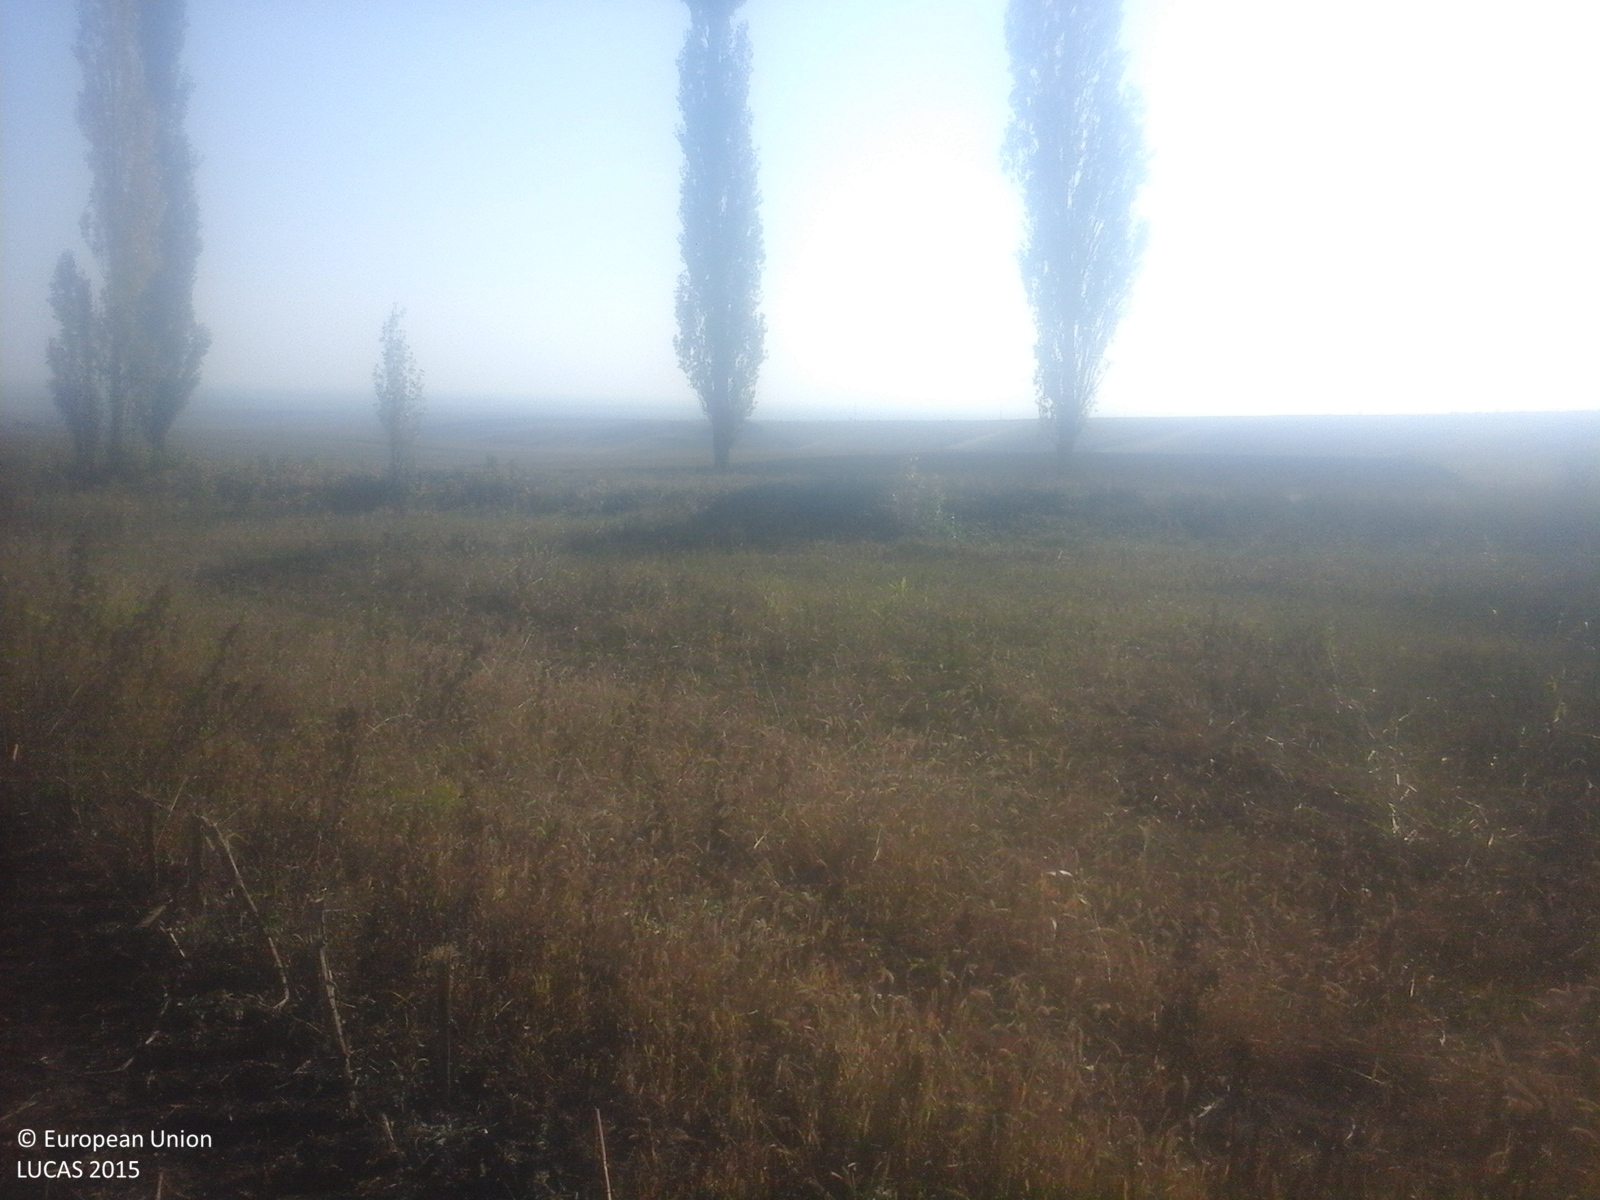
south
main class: Cropland
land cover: Sunflower
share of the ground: 25 - 50 %
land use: Agriculture (excluding fallow land and kitchen gardens)
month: October
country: RO
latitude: 45.3230
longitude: 26.9113
